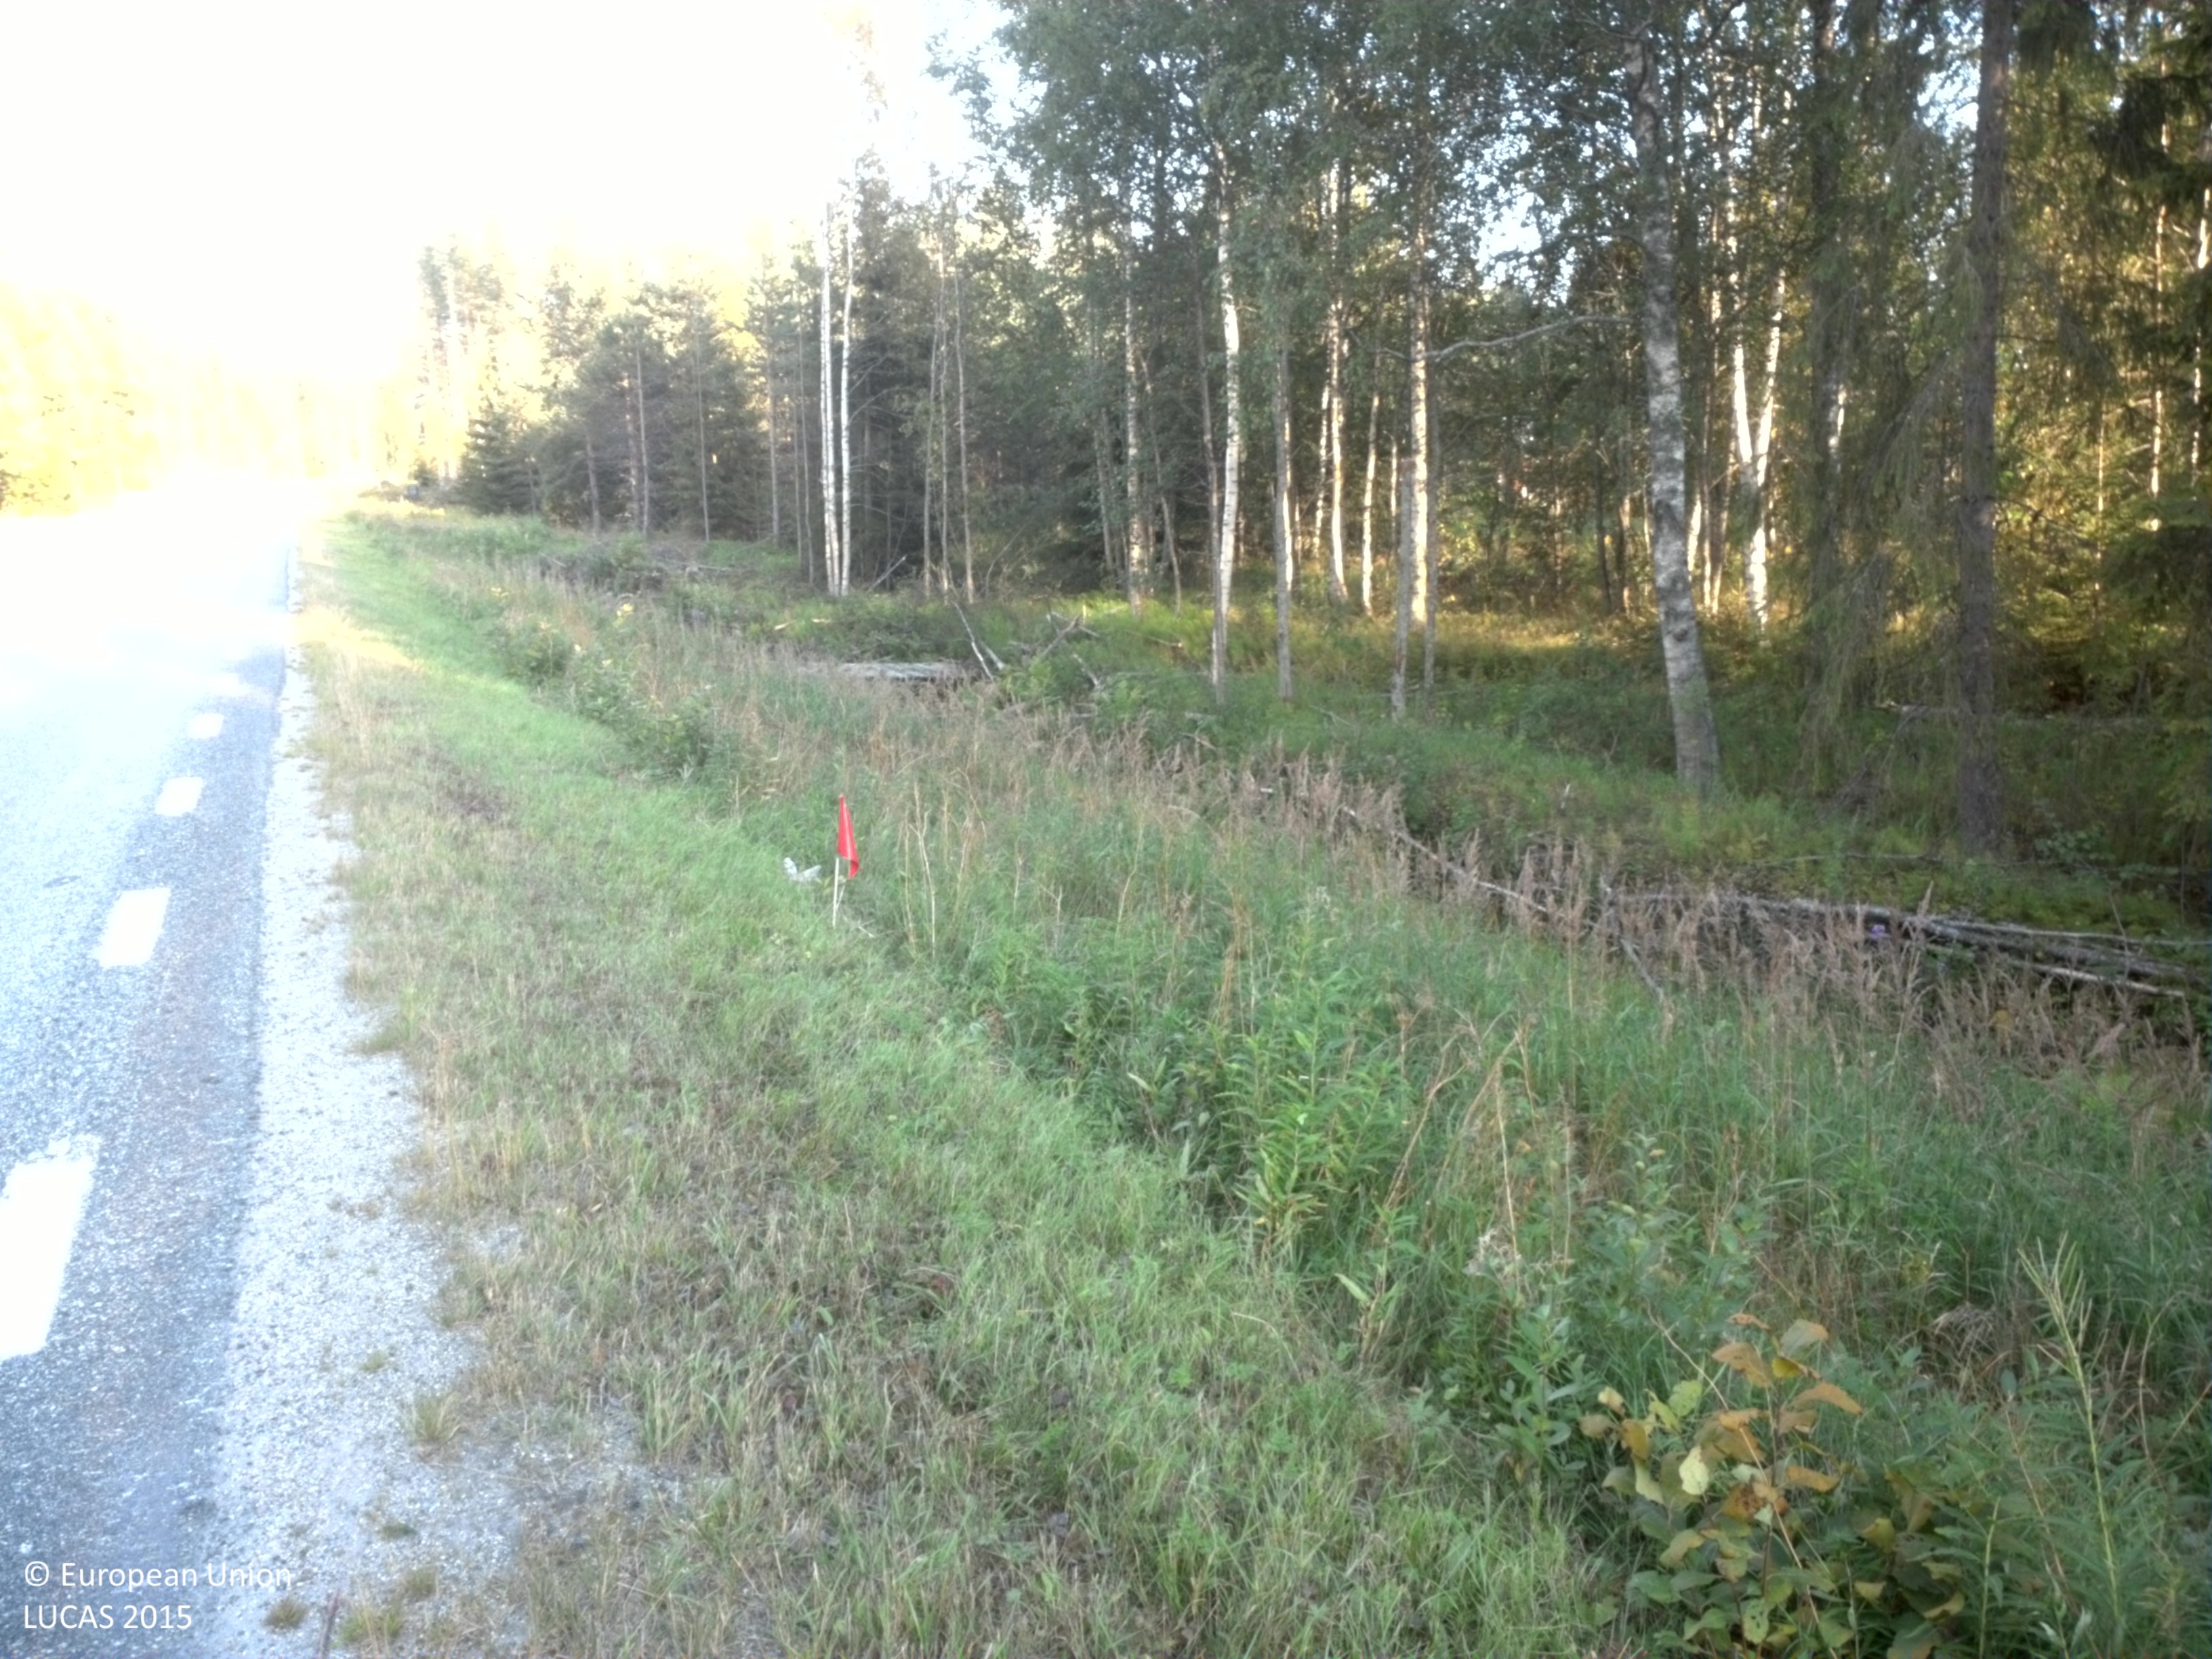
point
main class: Grassland
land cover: Grassland without tree/shrub cover
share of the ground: > 75 %
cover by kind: herbaceous plants 100 %
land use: Road transport
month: August
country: SE
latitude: 64.5139
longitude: 18.8632
